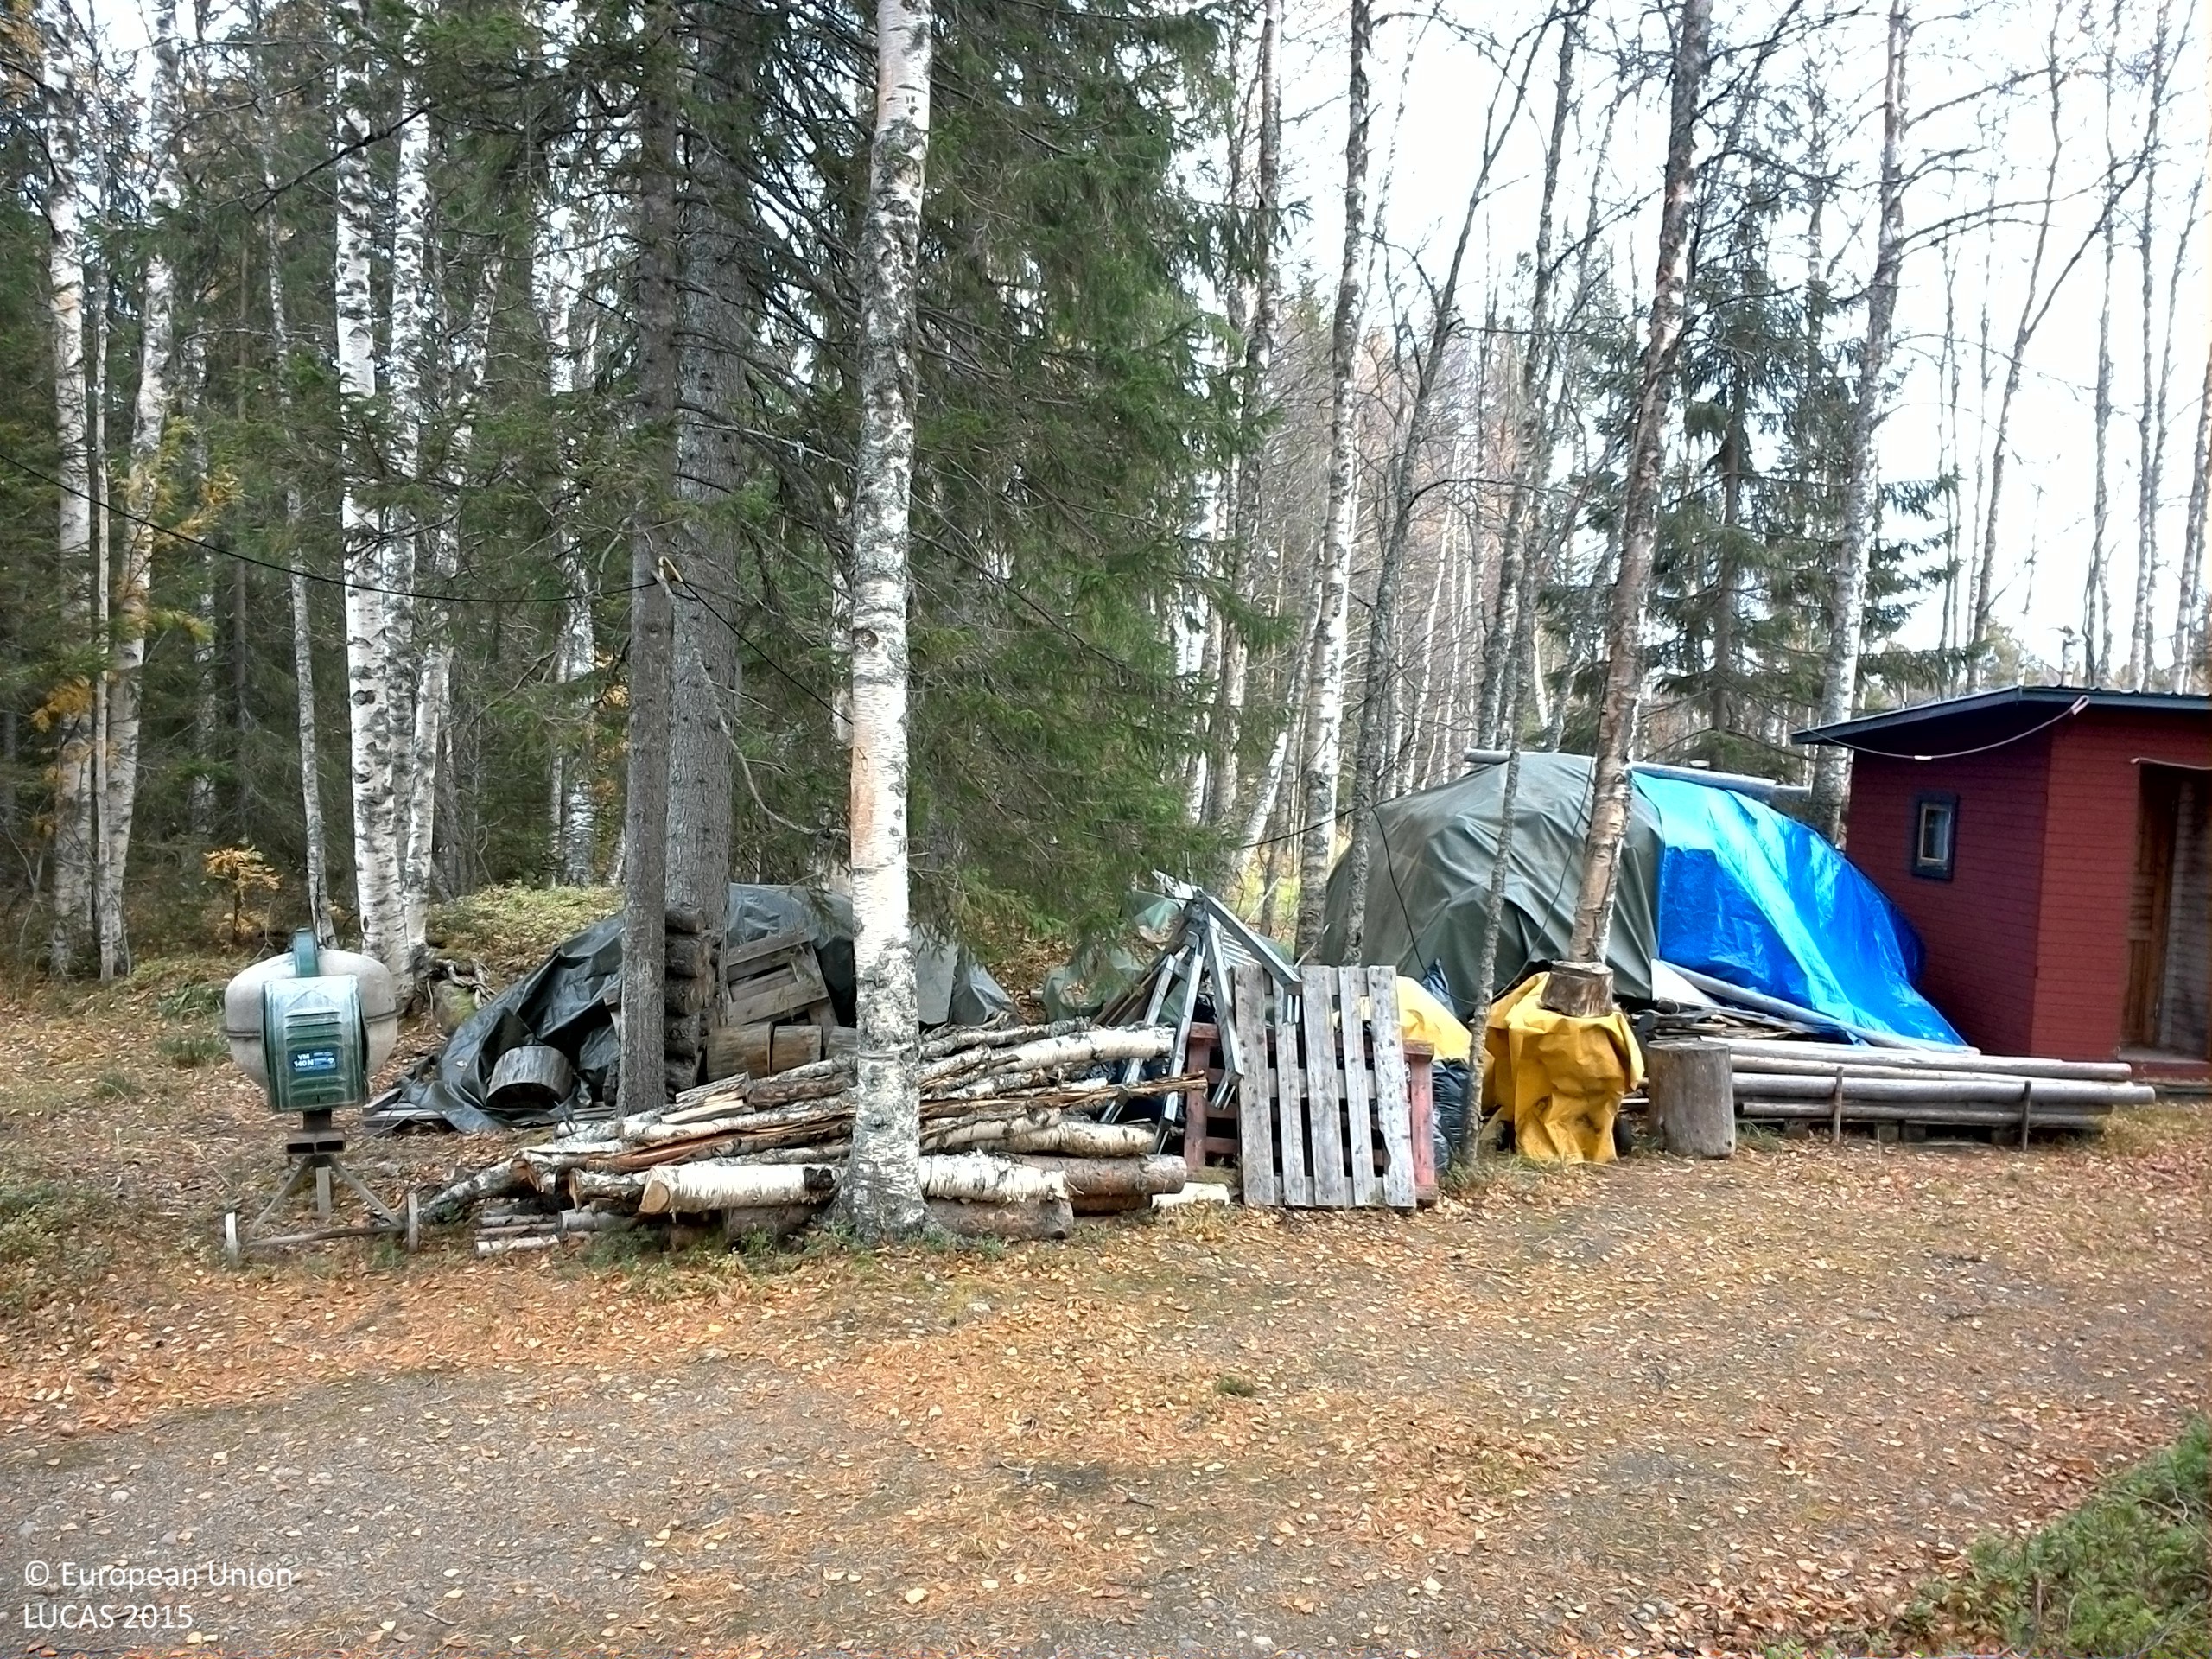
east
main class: Woodland
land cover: Pine dominated mixed woodland
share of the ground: 25 - 50 %
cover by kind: shrubs 50 %, coniferous forest trees 15 %, broadleaved forest trees 10 %, lichens and mosses 10 %, consolidated bare surface 5 %
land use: Residential
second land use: Forestry
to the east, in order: Pine dominated mixed woodland; Artificial constructions in urban areas; Spruce dominated mixed woodland; Ditches and canals; Spruce dominated mixed woodland; Broadleaved woodland; Grassland without tree/shrub cover; Electric lines; Grassland without tree/shrub cover; Managed hedges; Grass margins; Ditches and canals; Paved roads, cycling and walking lanes; Ditches and canals; Grass margins; Grassland without tree/shrub cover; Single bushes/trees; Grassland without tree/shrub cover; Spruce dominated coniferous woodland; Rivers and streams; Spruce dominated mixed woodland
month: October
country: SE
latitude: 64.0533
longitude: 15.8916
